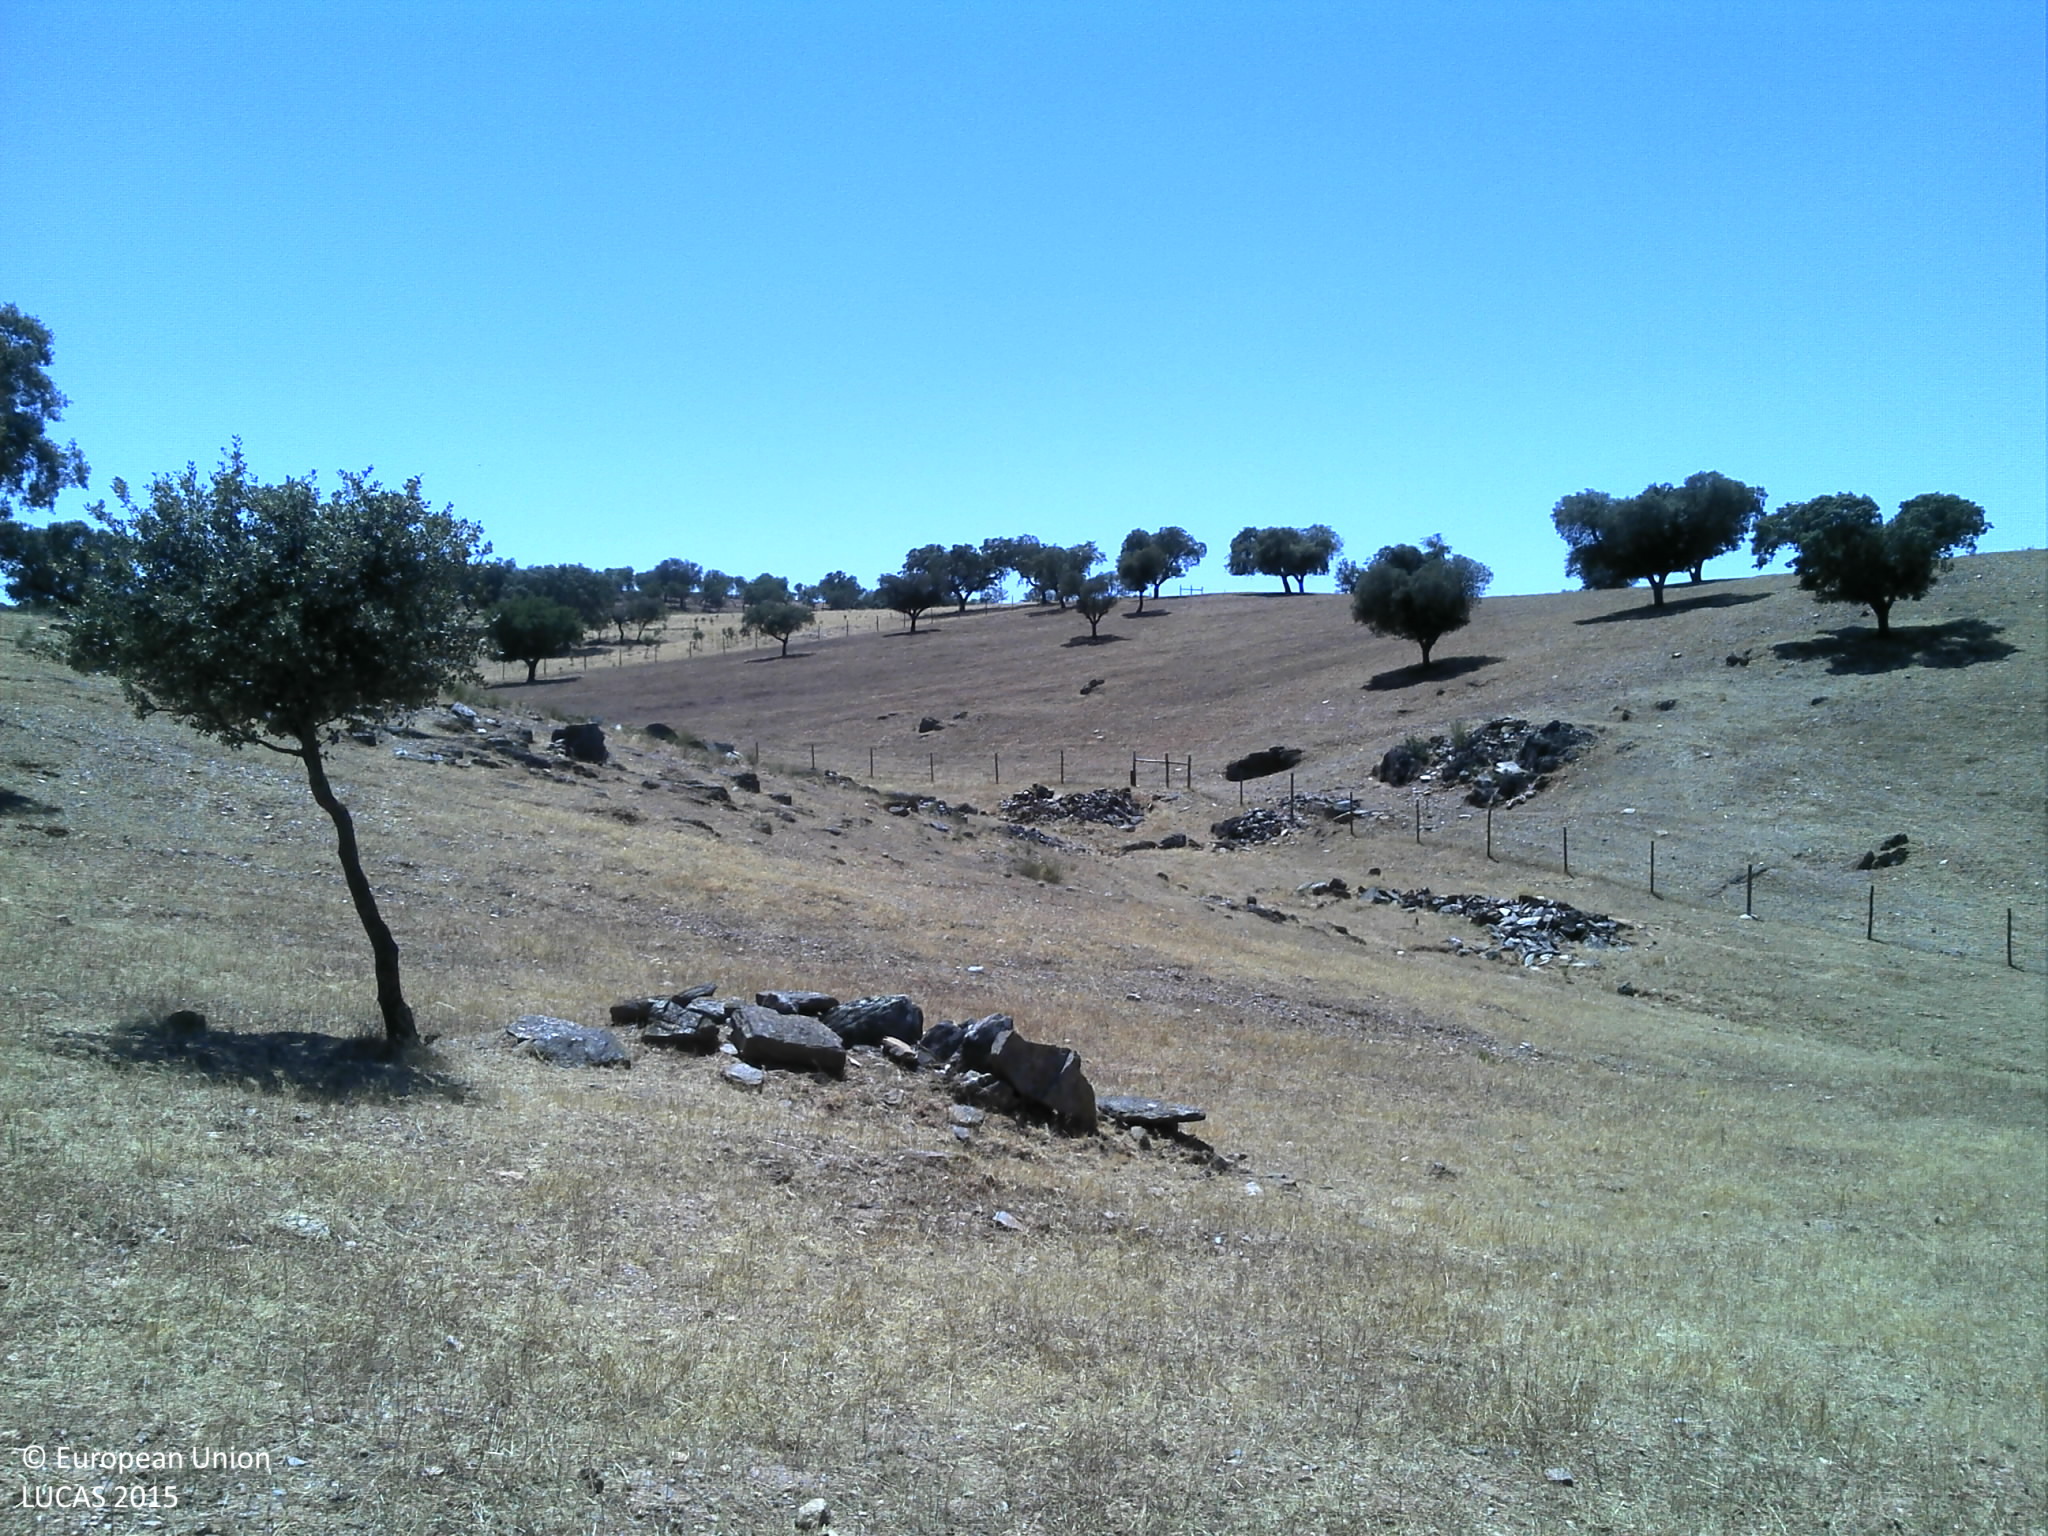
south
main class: Grassland
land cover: Grassland without tree/shrub cover
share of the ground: 25 - 50 %
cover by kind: unconsolidated bare surface 75 %, herbaceous plants 25 %
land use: Agriculture (excluding fallow land and kitchen gardens)
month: July
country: PT
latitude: 38.9498
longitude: -7.5418
